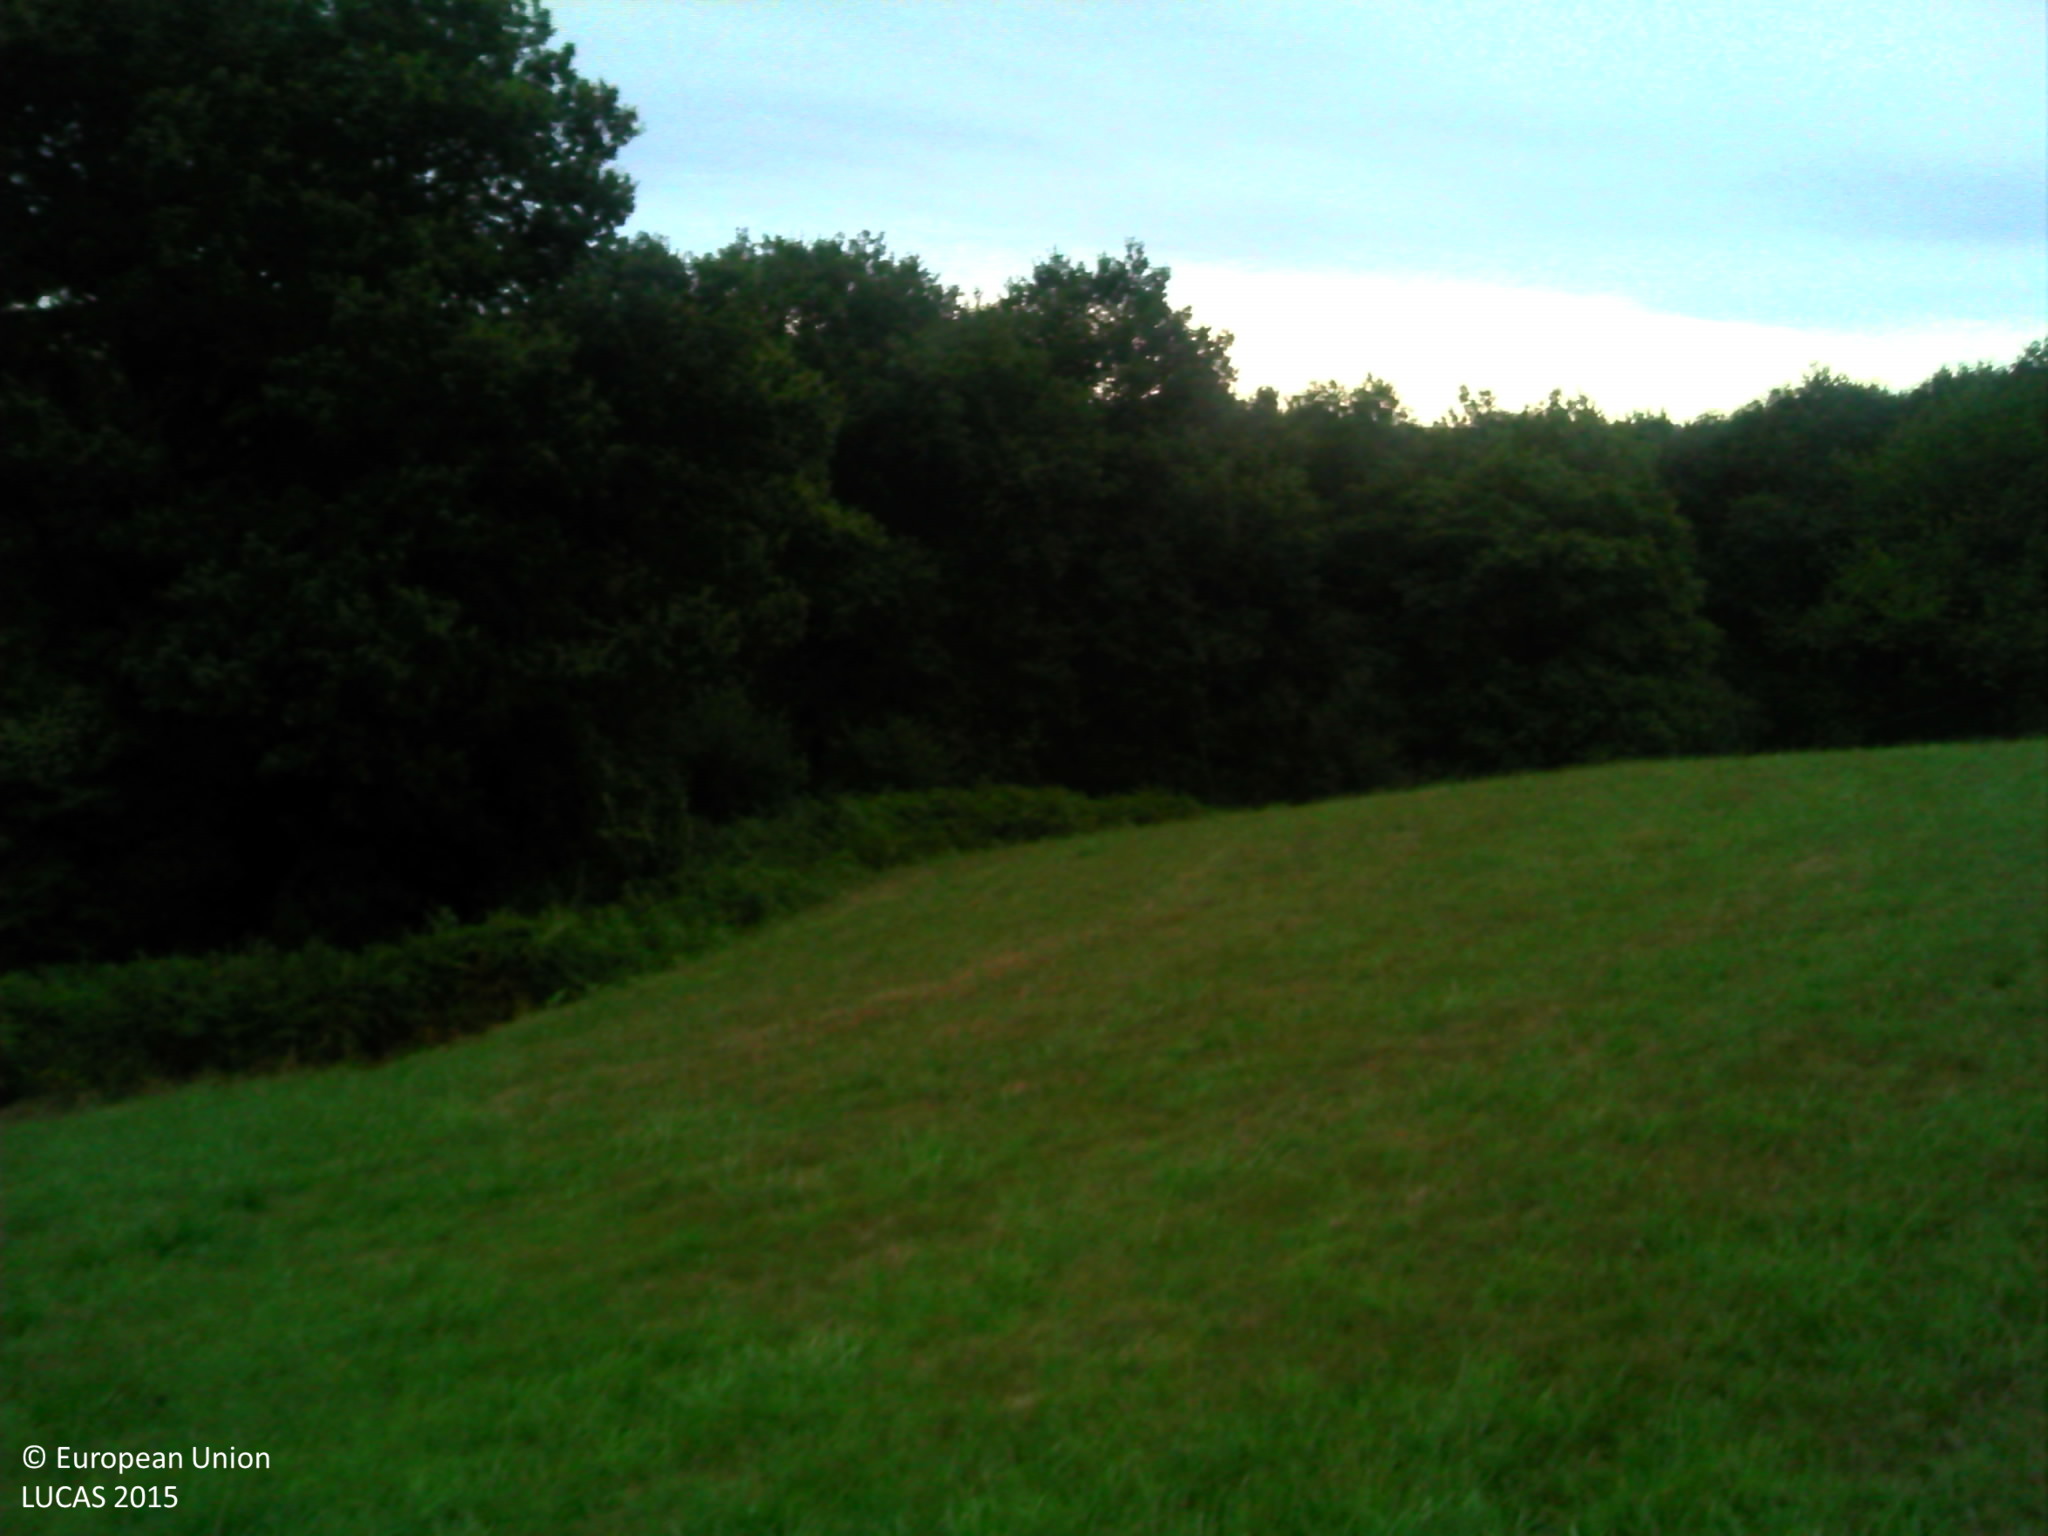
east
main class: Grassland
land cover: Grassland without tree/shrub cover
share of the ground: > 75 %
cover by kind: herbaceous plants 100 %
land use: Agriculture (excluding fallow land and kitchen gardens)
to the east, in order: Grassland without tree/shrub cover; Shruby margins; Broadleaved woodland; Tracks; Broadleaved woodland; Rivers and streams; Shruby margins; Broadleaved woodland; Fences; Grassland without tree/shrub cover
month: August
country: FR
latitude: 43.4512
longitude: -1.1988
